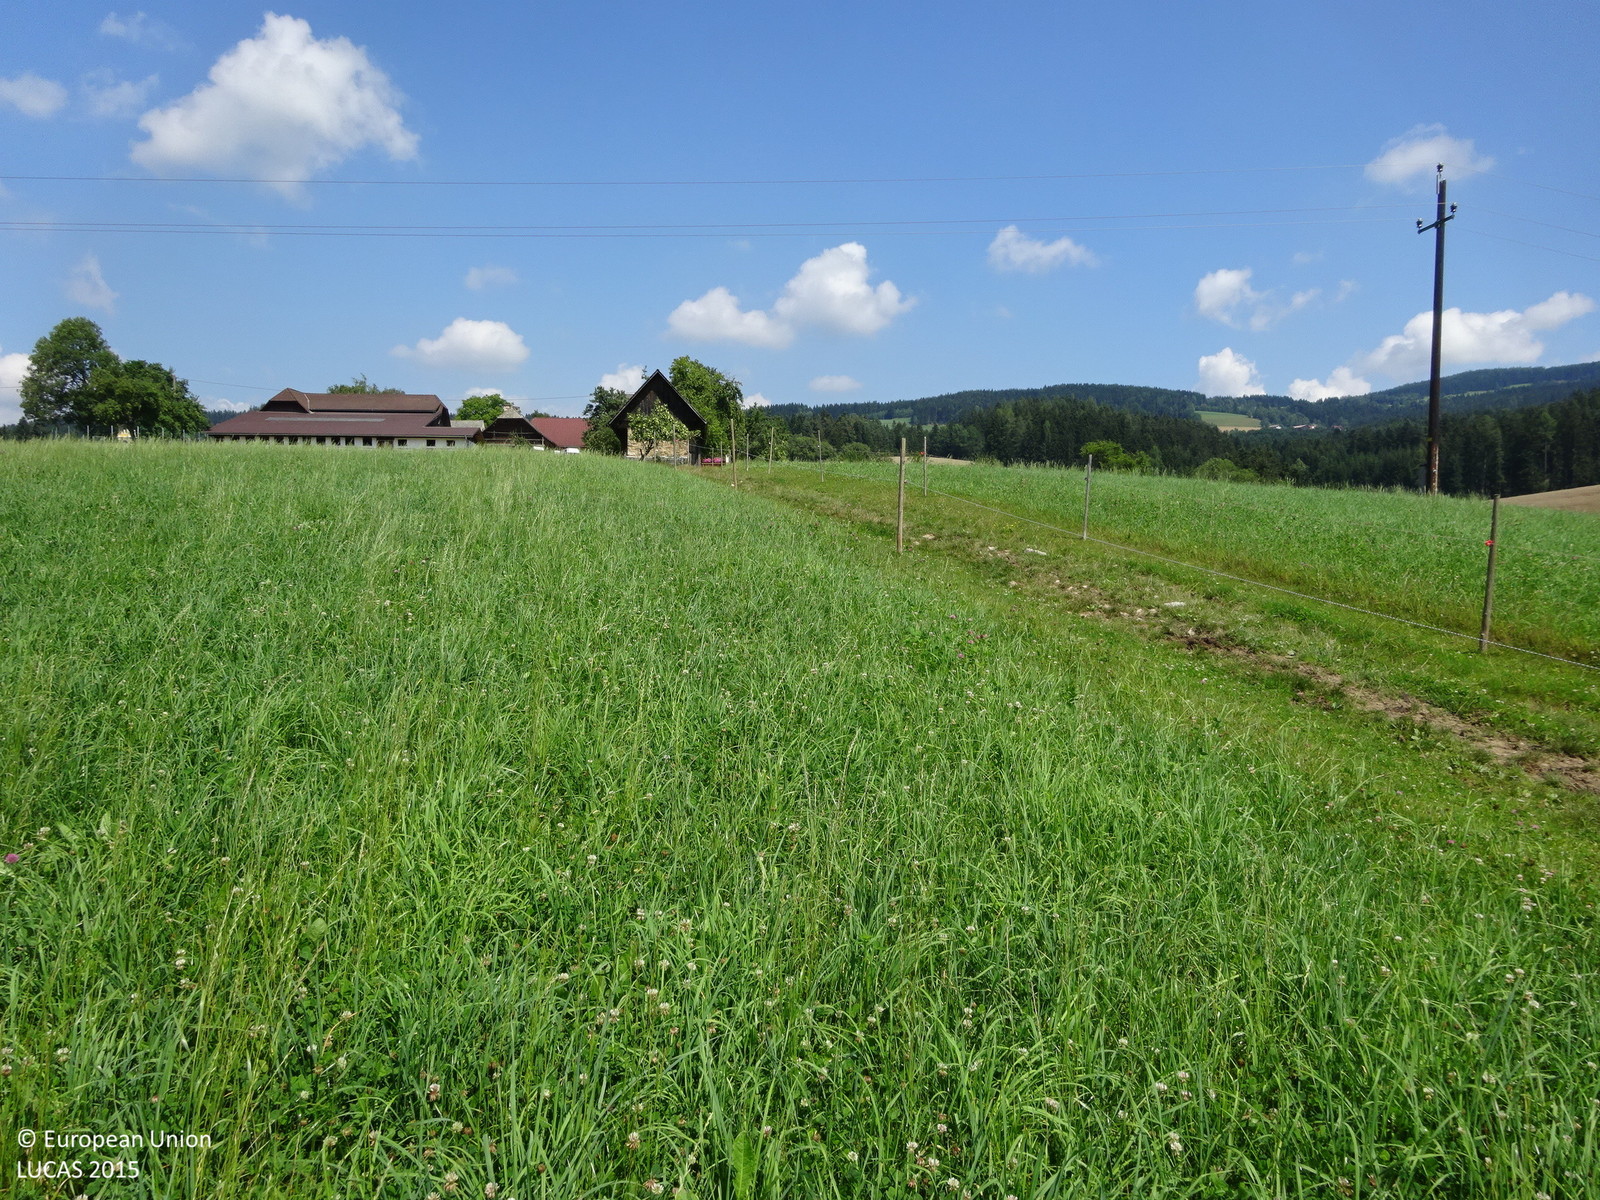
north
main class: Grassland
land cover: Grassland without tree/shrub cover
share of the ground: > 75 %
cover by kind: herbaceous plants 100 %
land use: Agriculture (excluding fallow land and kitchen gardens)
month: August
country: AT
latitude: 47.3706
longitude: 15.7353
